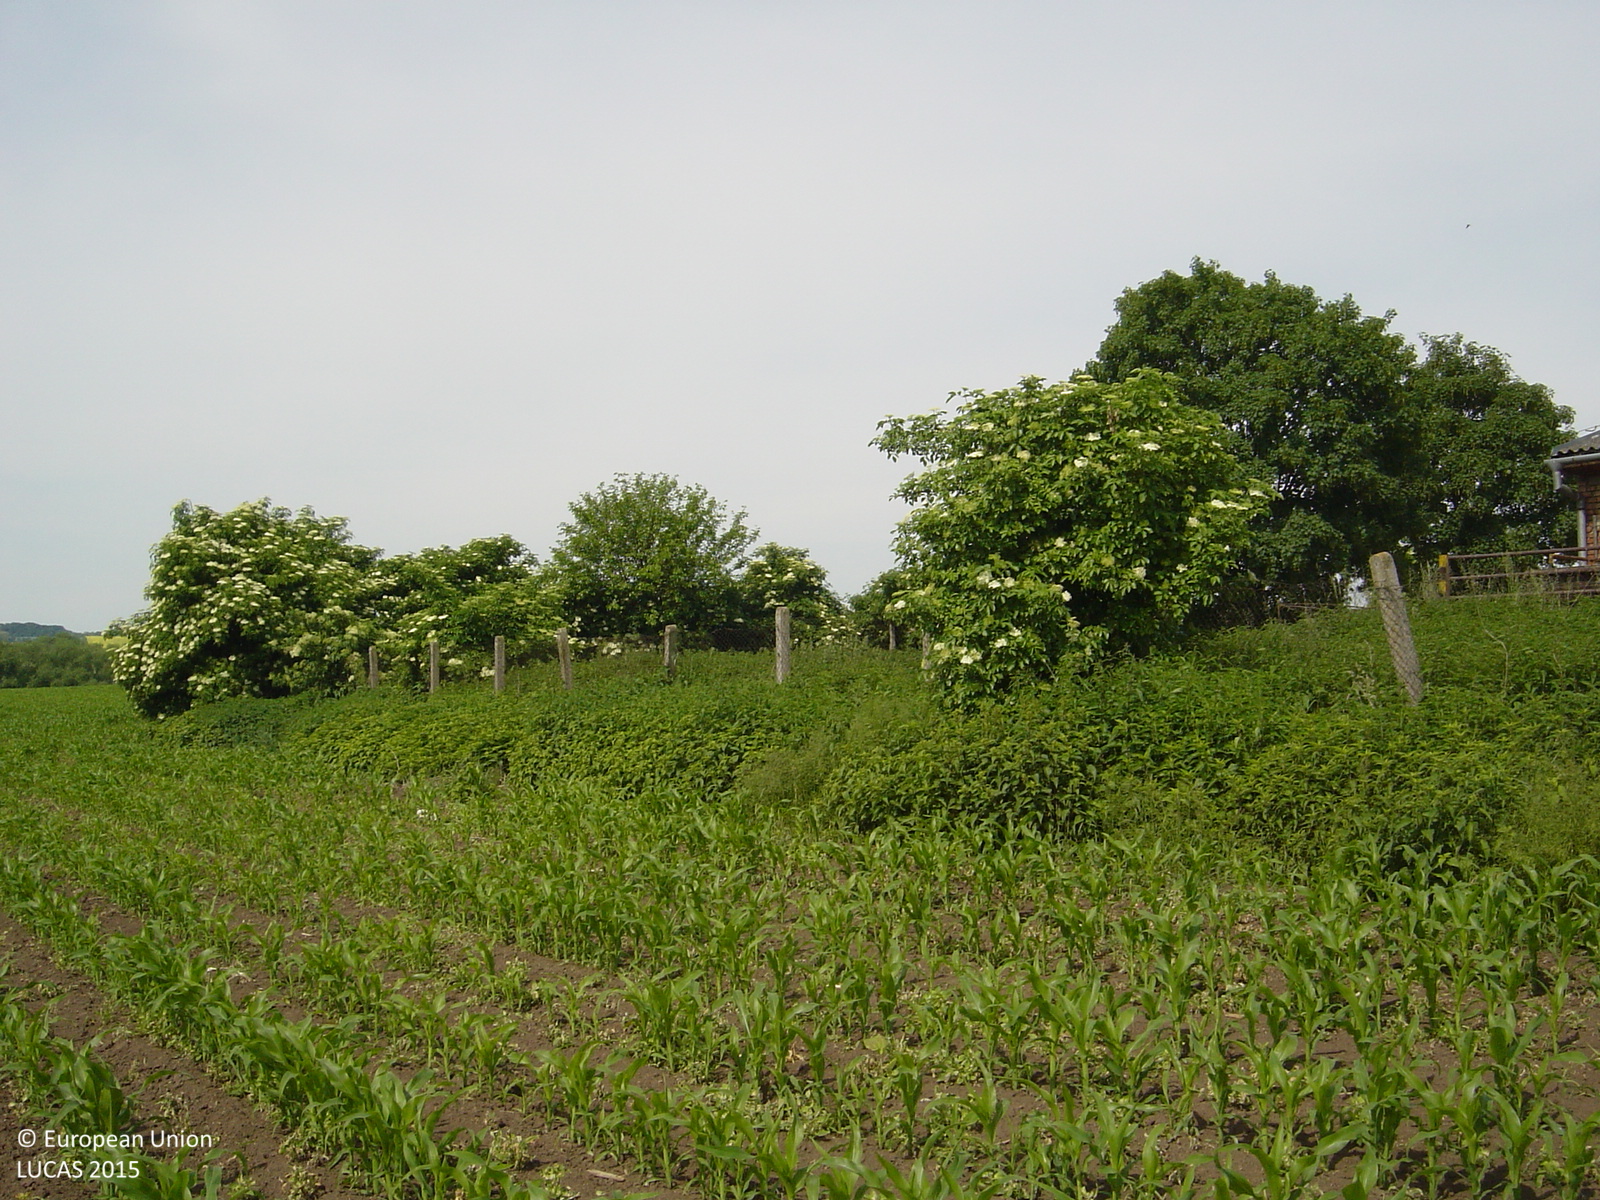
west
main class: Cropland
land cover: Maize
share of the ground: 25 - 50 %
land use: Agriculture (excluding fallow land and kitchen gardens)
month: June
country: CZ
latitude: 49.1701
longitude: 17.0730
